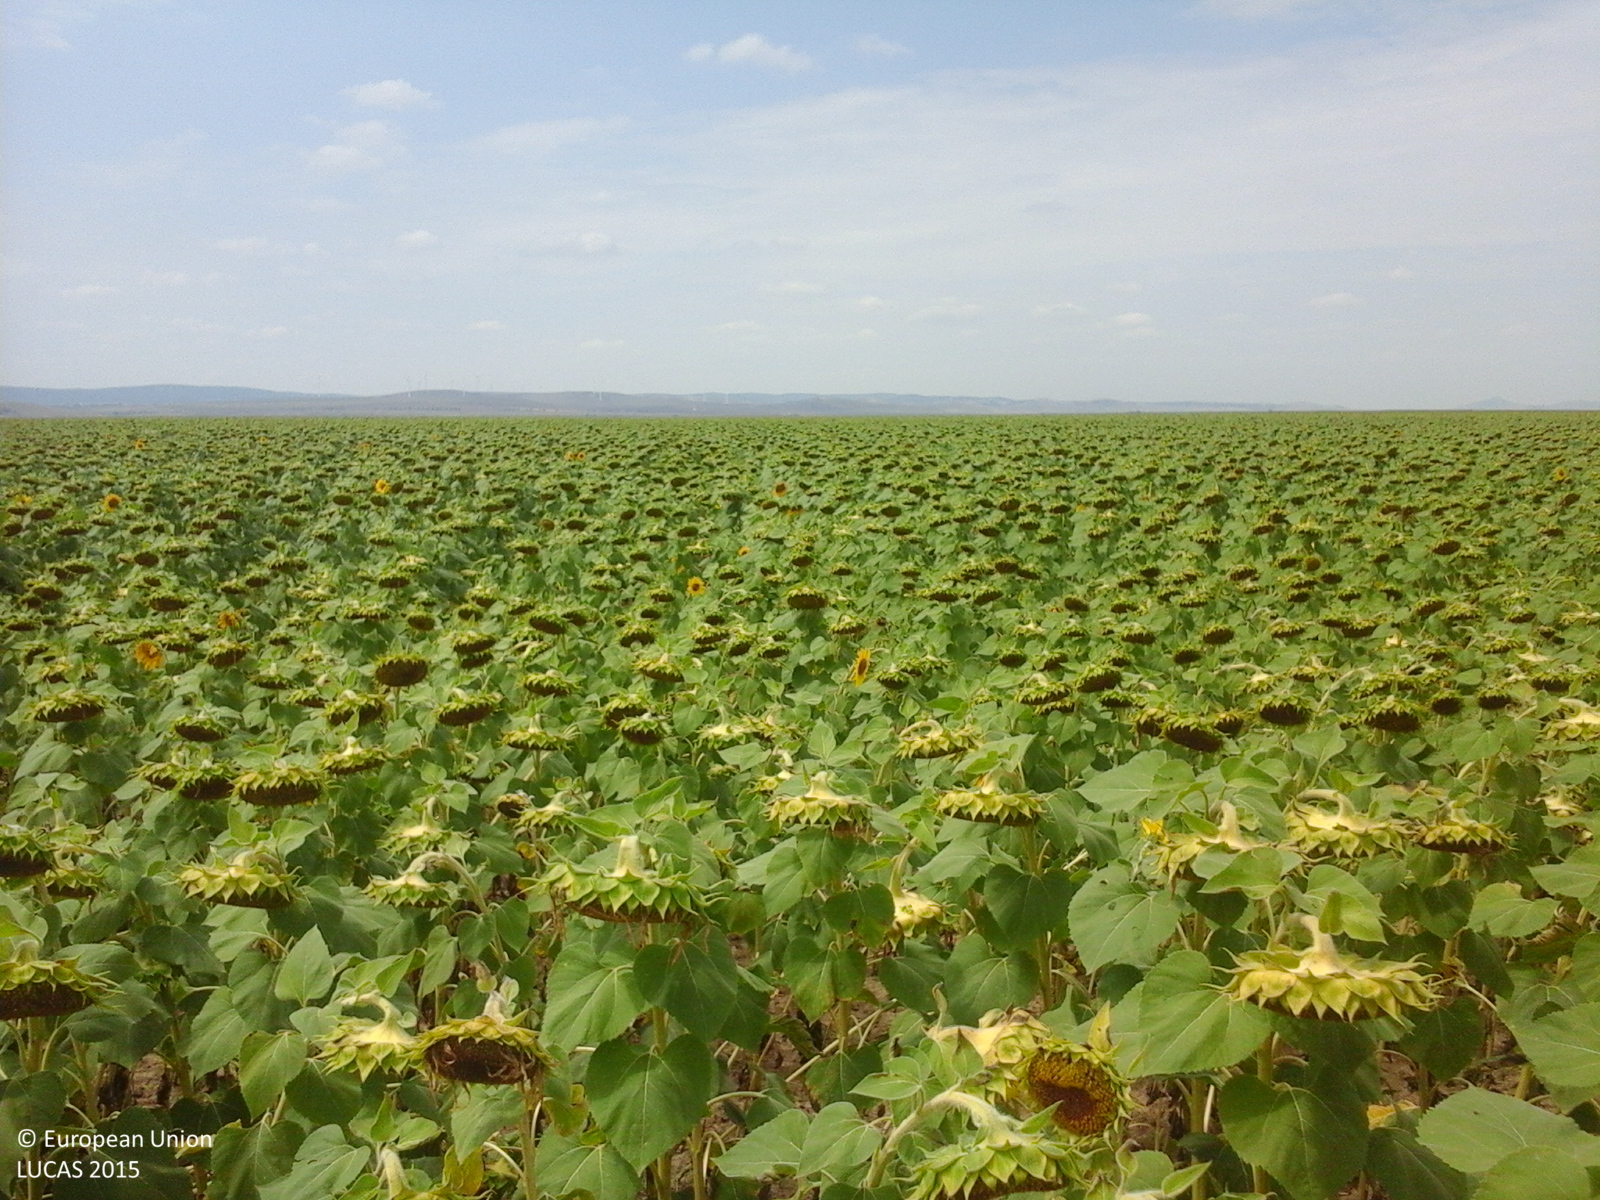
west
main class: Cropland
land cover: Sunflower
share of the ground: > 75 %
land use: Agriculture (excluding fallow land and kitchen gardens)
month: August
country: RO
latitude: 44.9232
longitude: 28.7995
